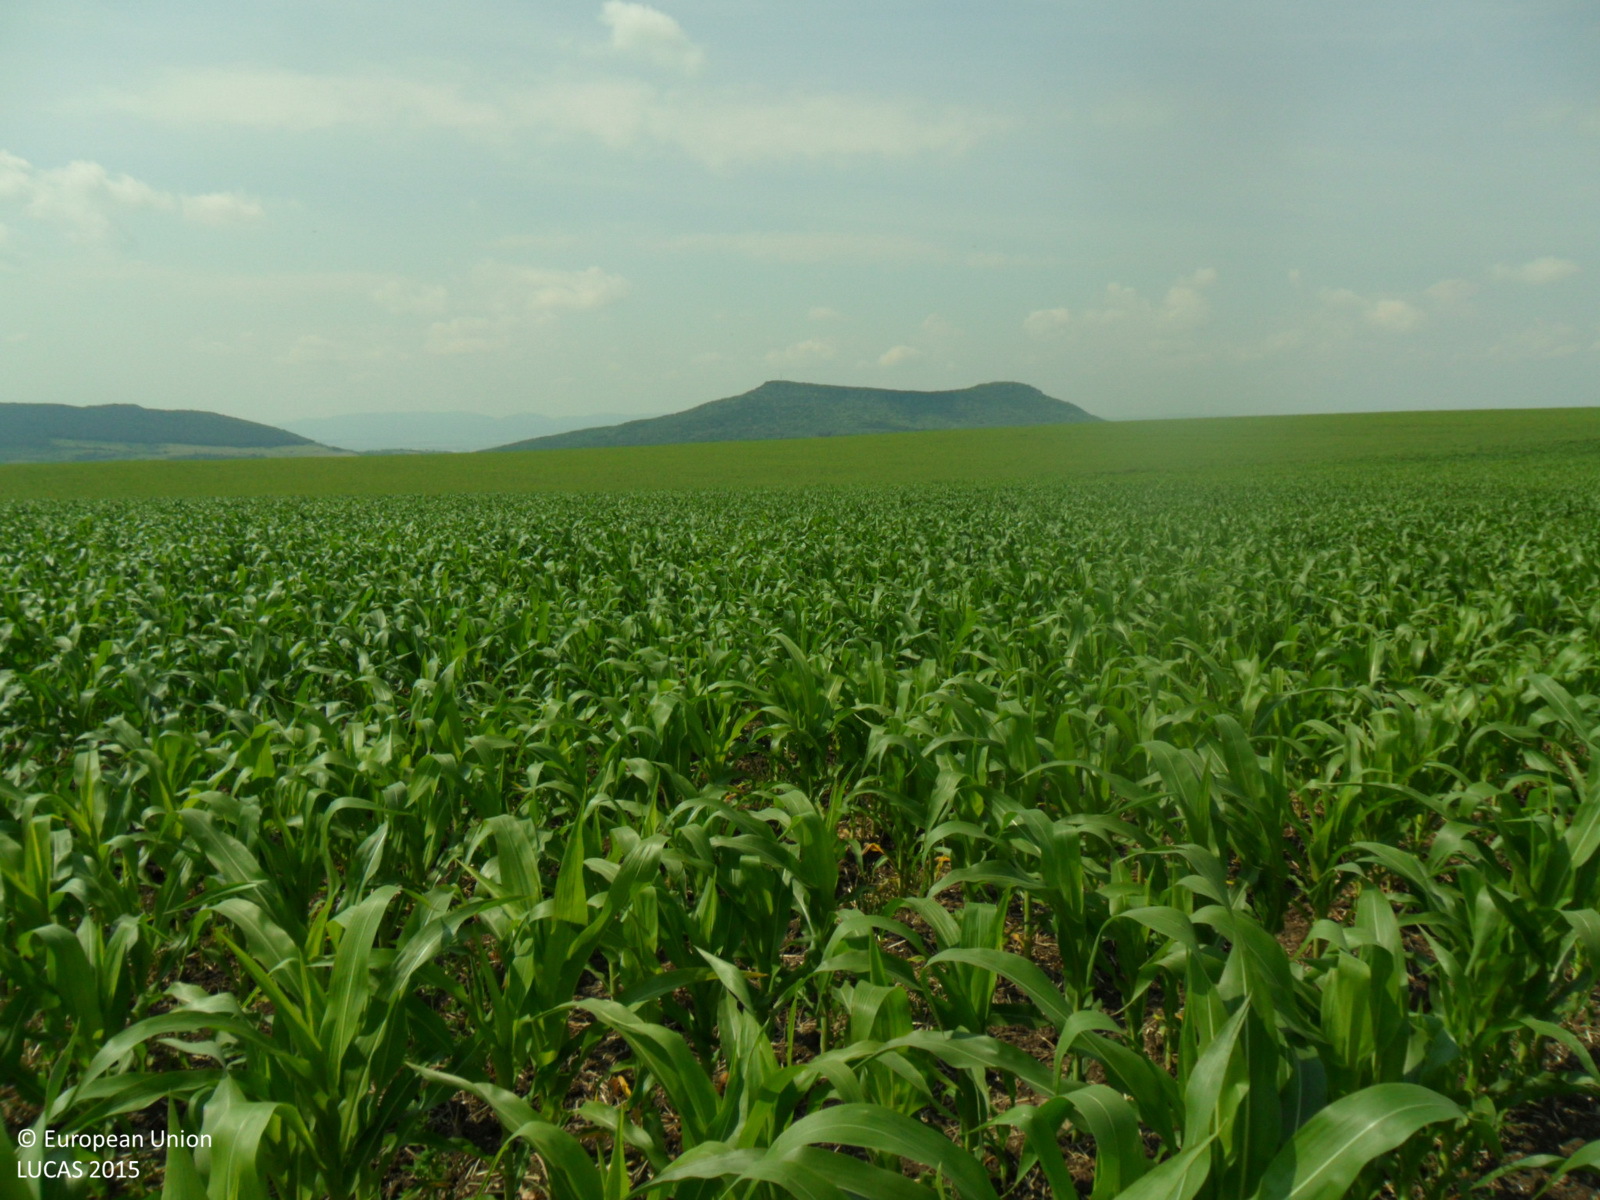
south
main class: Cropland
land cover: Maize
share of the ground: > 75 %
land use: Agriculture (excluding fallow land and kitchen gardens)
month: June
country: BG
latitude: 43.3586
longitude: 26.7796
